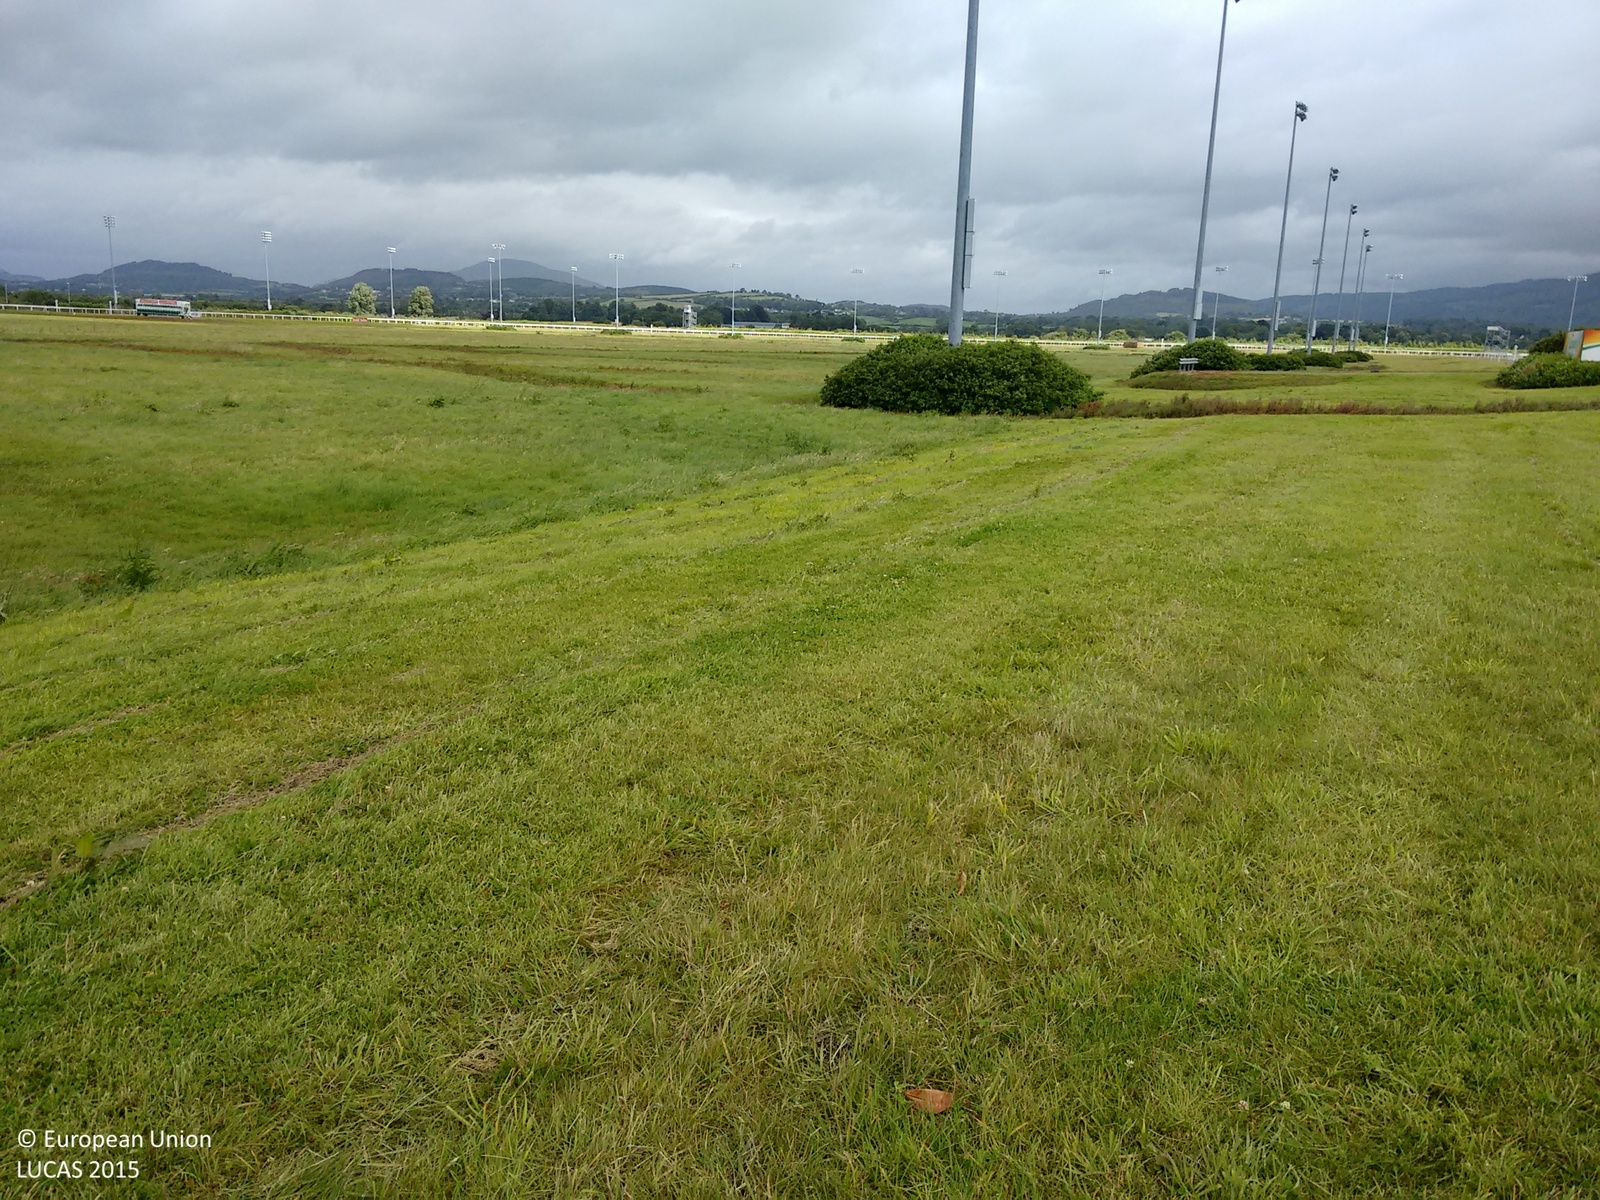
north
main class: Grassland
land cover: Grassland without tree/shrub cover
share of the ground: > 75 %
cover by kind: herbaceous plants 100 %
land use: Amenities, museums, leisure
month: August
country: IE
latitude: 54.0213
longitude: -6.3776
